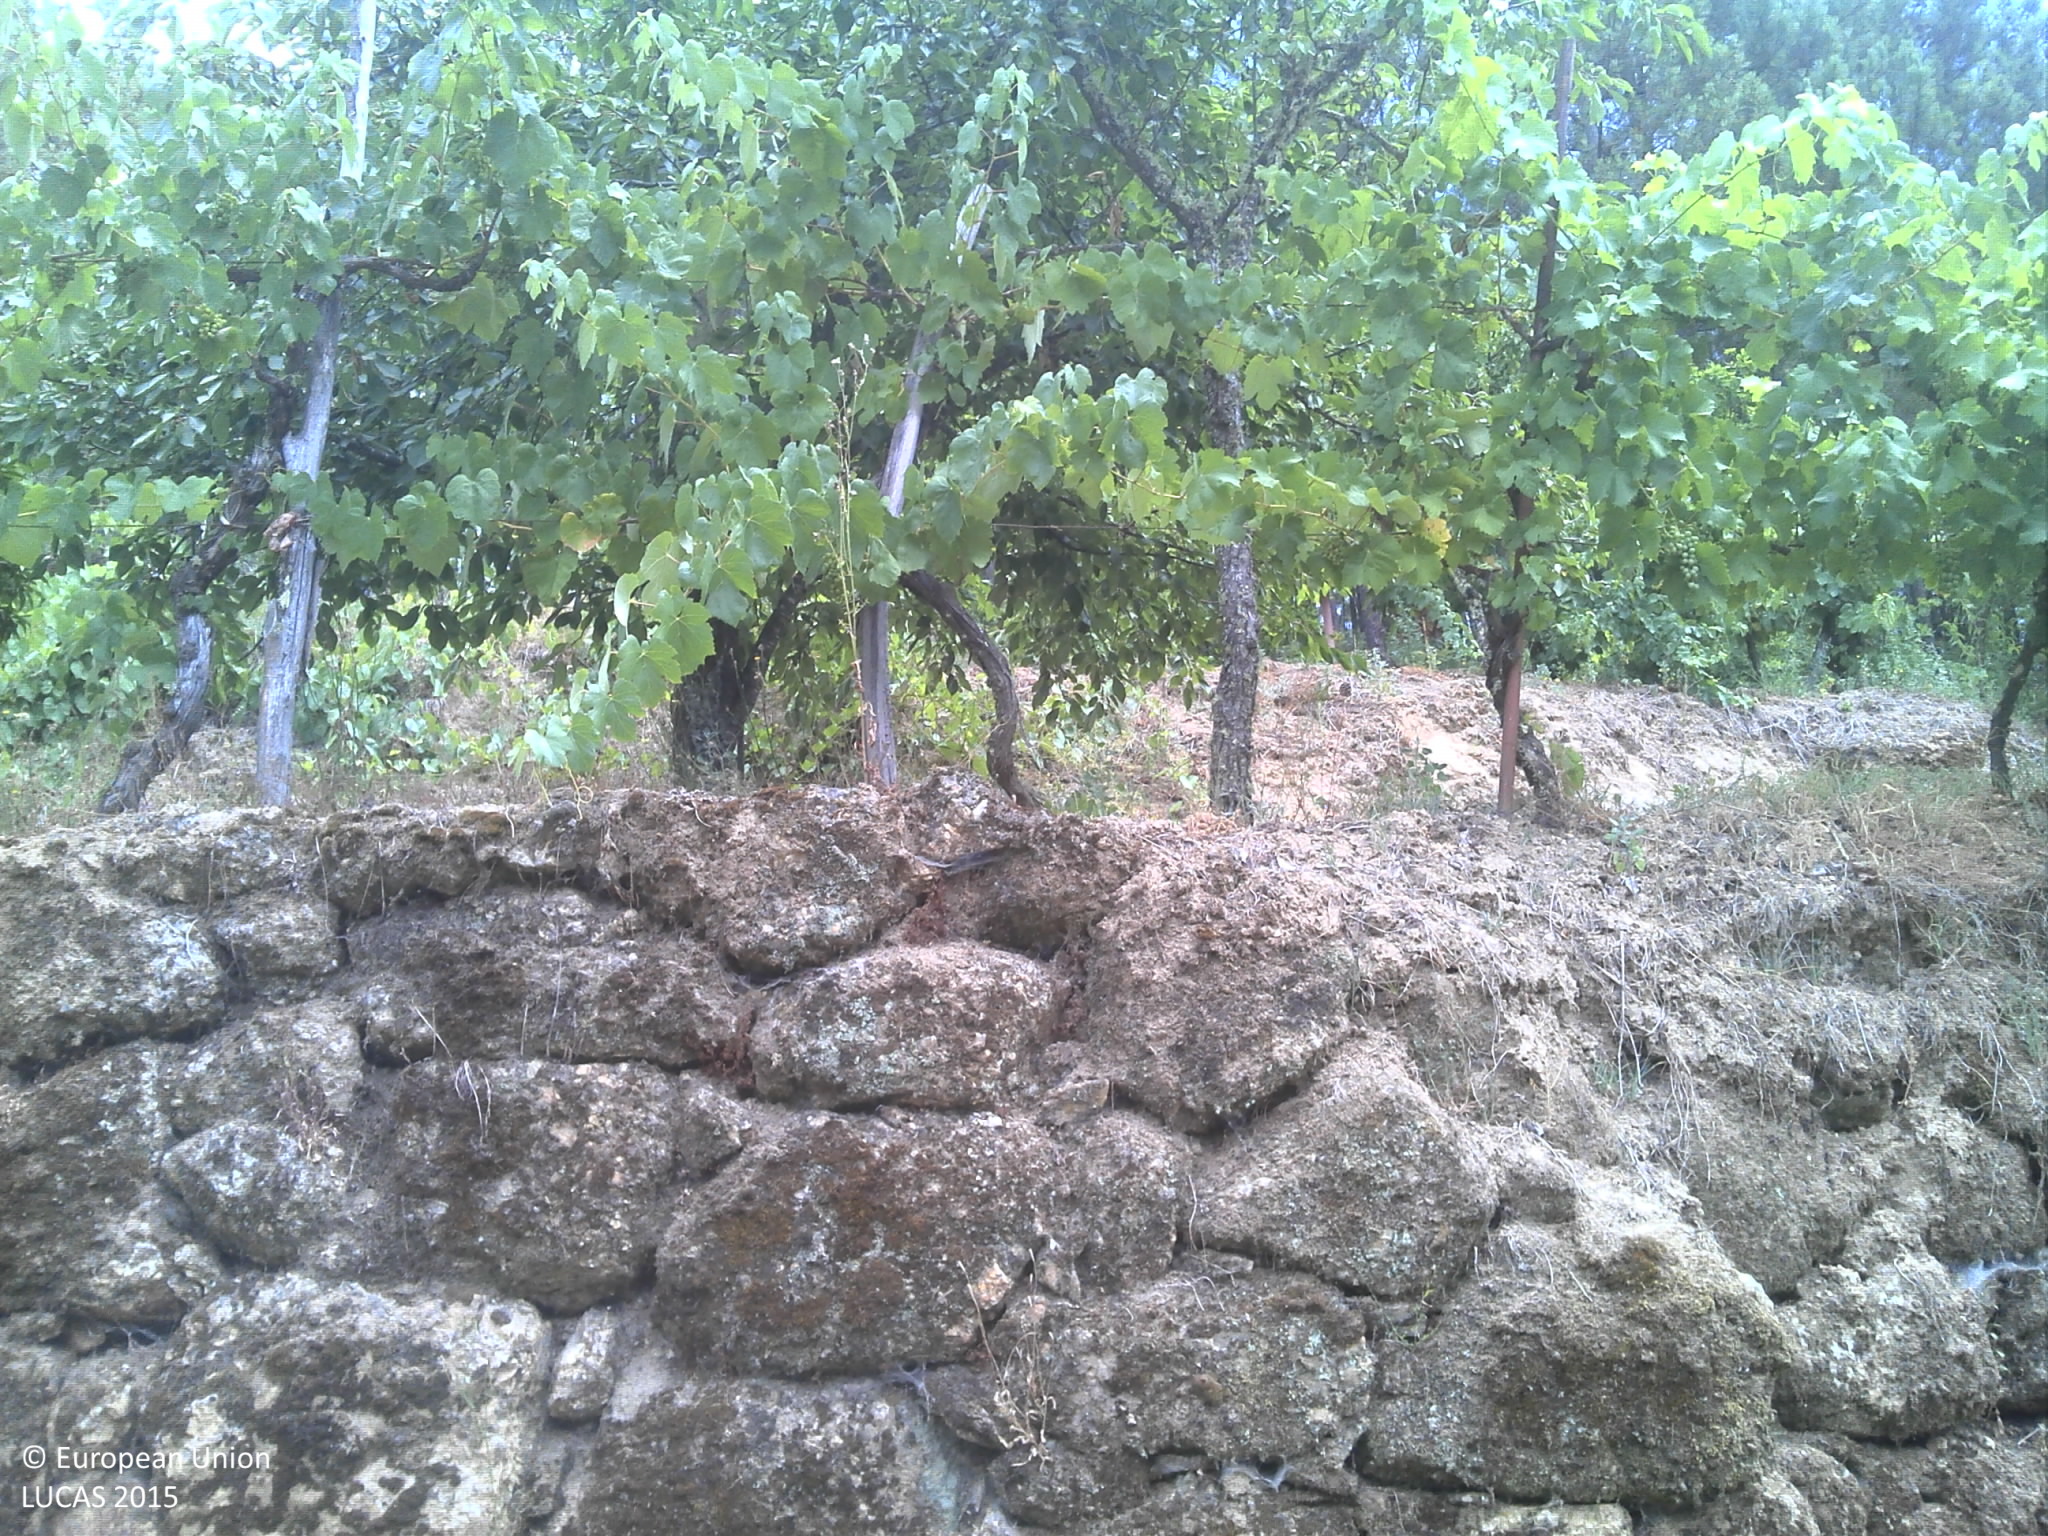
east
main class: Grassland
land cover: Spontaneously vegetated surfaces
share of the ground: 25 - 50 %
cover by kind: unconsolidated bare surface 60 %, herbaceous plants 40 %
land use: Fallow land
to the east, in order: Spontaneously vegetated surfaces; Dry stone walls; Vineyards; Cherry fruit; Vineyards; Grassland without tree/shrub cover; Pine dominated coniferous woodland; Shrubland without tree cover; Tracks; Shrubland without tree cover; Pine dominated coniferous woodland; Olive groves; Pine dominated coniferous woodland; Dry stone walls; Tracks; Dry stone walls; Olive groves; Dry stone walls; Abandoned hedges; Spontaneously vegetated surfaces
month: July
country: PT
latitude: 40.3842
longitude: -7.7735
